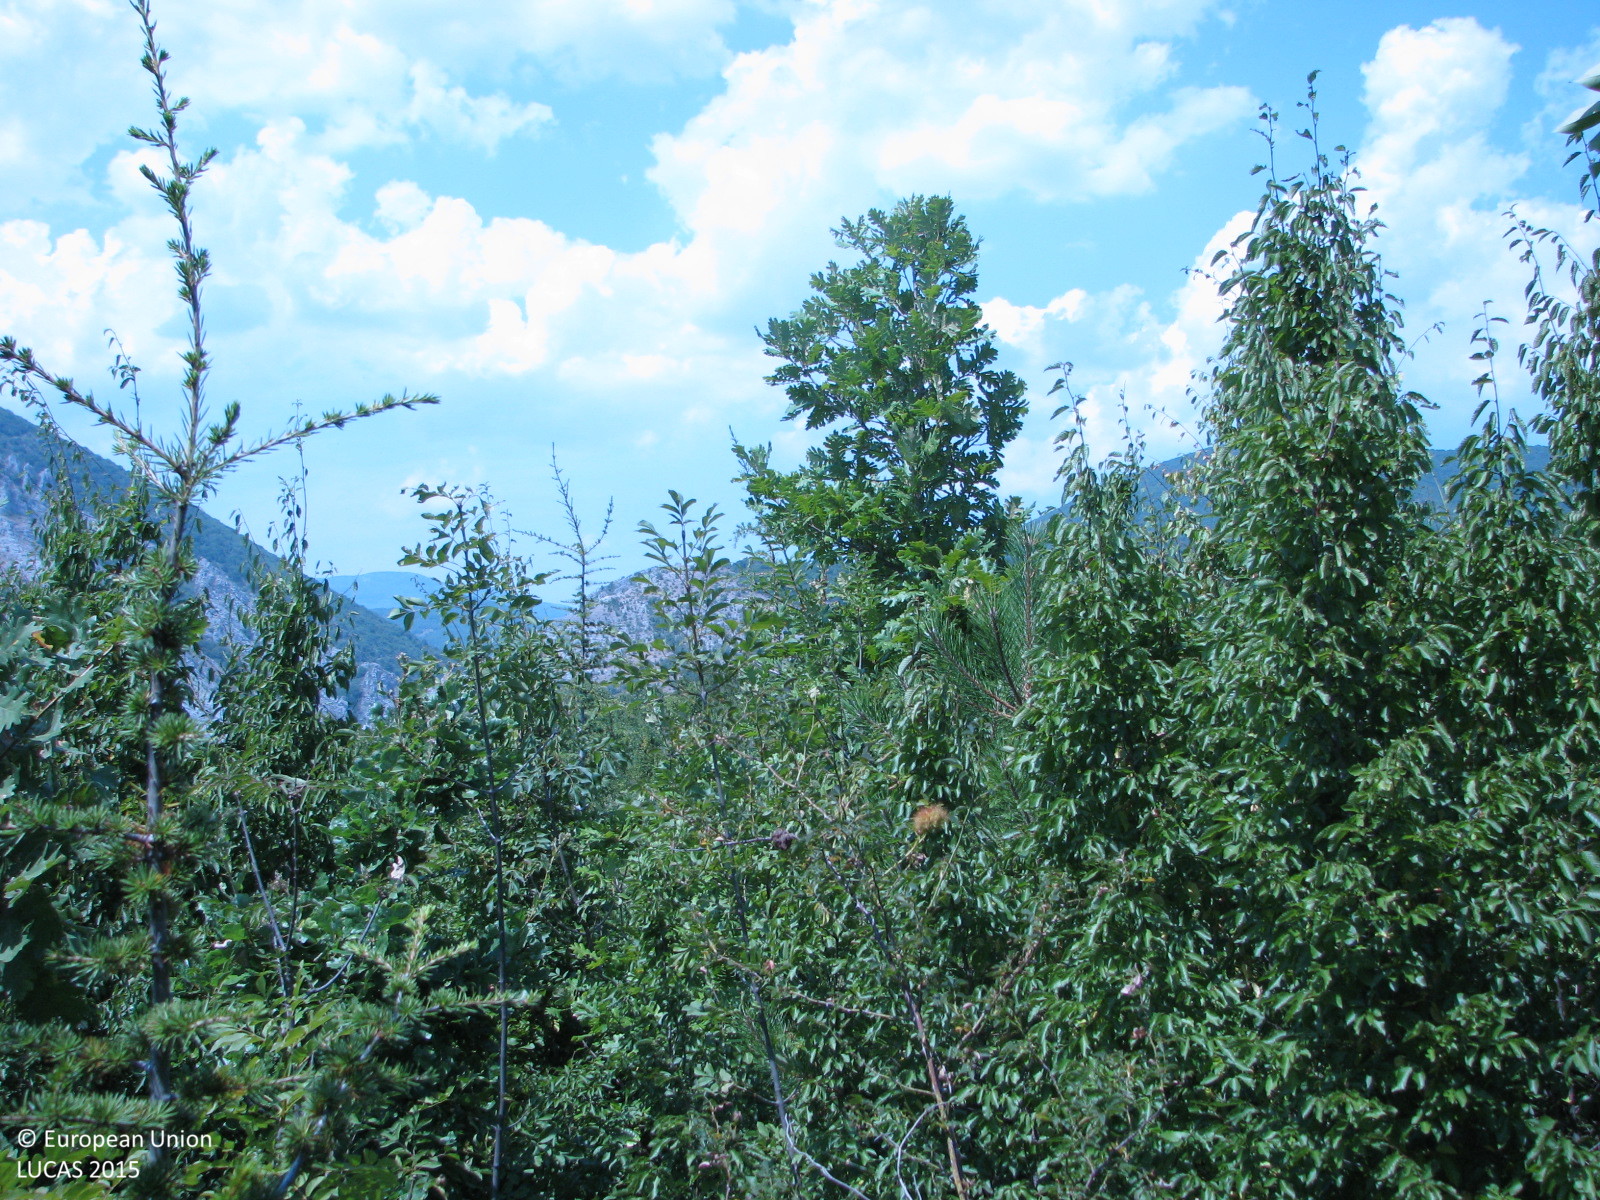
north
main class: Woodland
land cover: Broadleaved woodland
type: hemiboreal forest and nemoral coniferous forest and mixed broadleaved-coniferous forest
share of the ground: 50 - 75 %
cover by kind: broadleaved forest trees 40 %, herbaceous plants 30 %, shrubs 20 %, coniferous forest trees 10 %
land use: Forestry
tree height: > 5 m
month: July
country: BG
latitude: 42.6818
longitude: 26.0843
